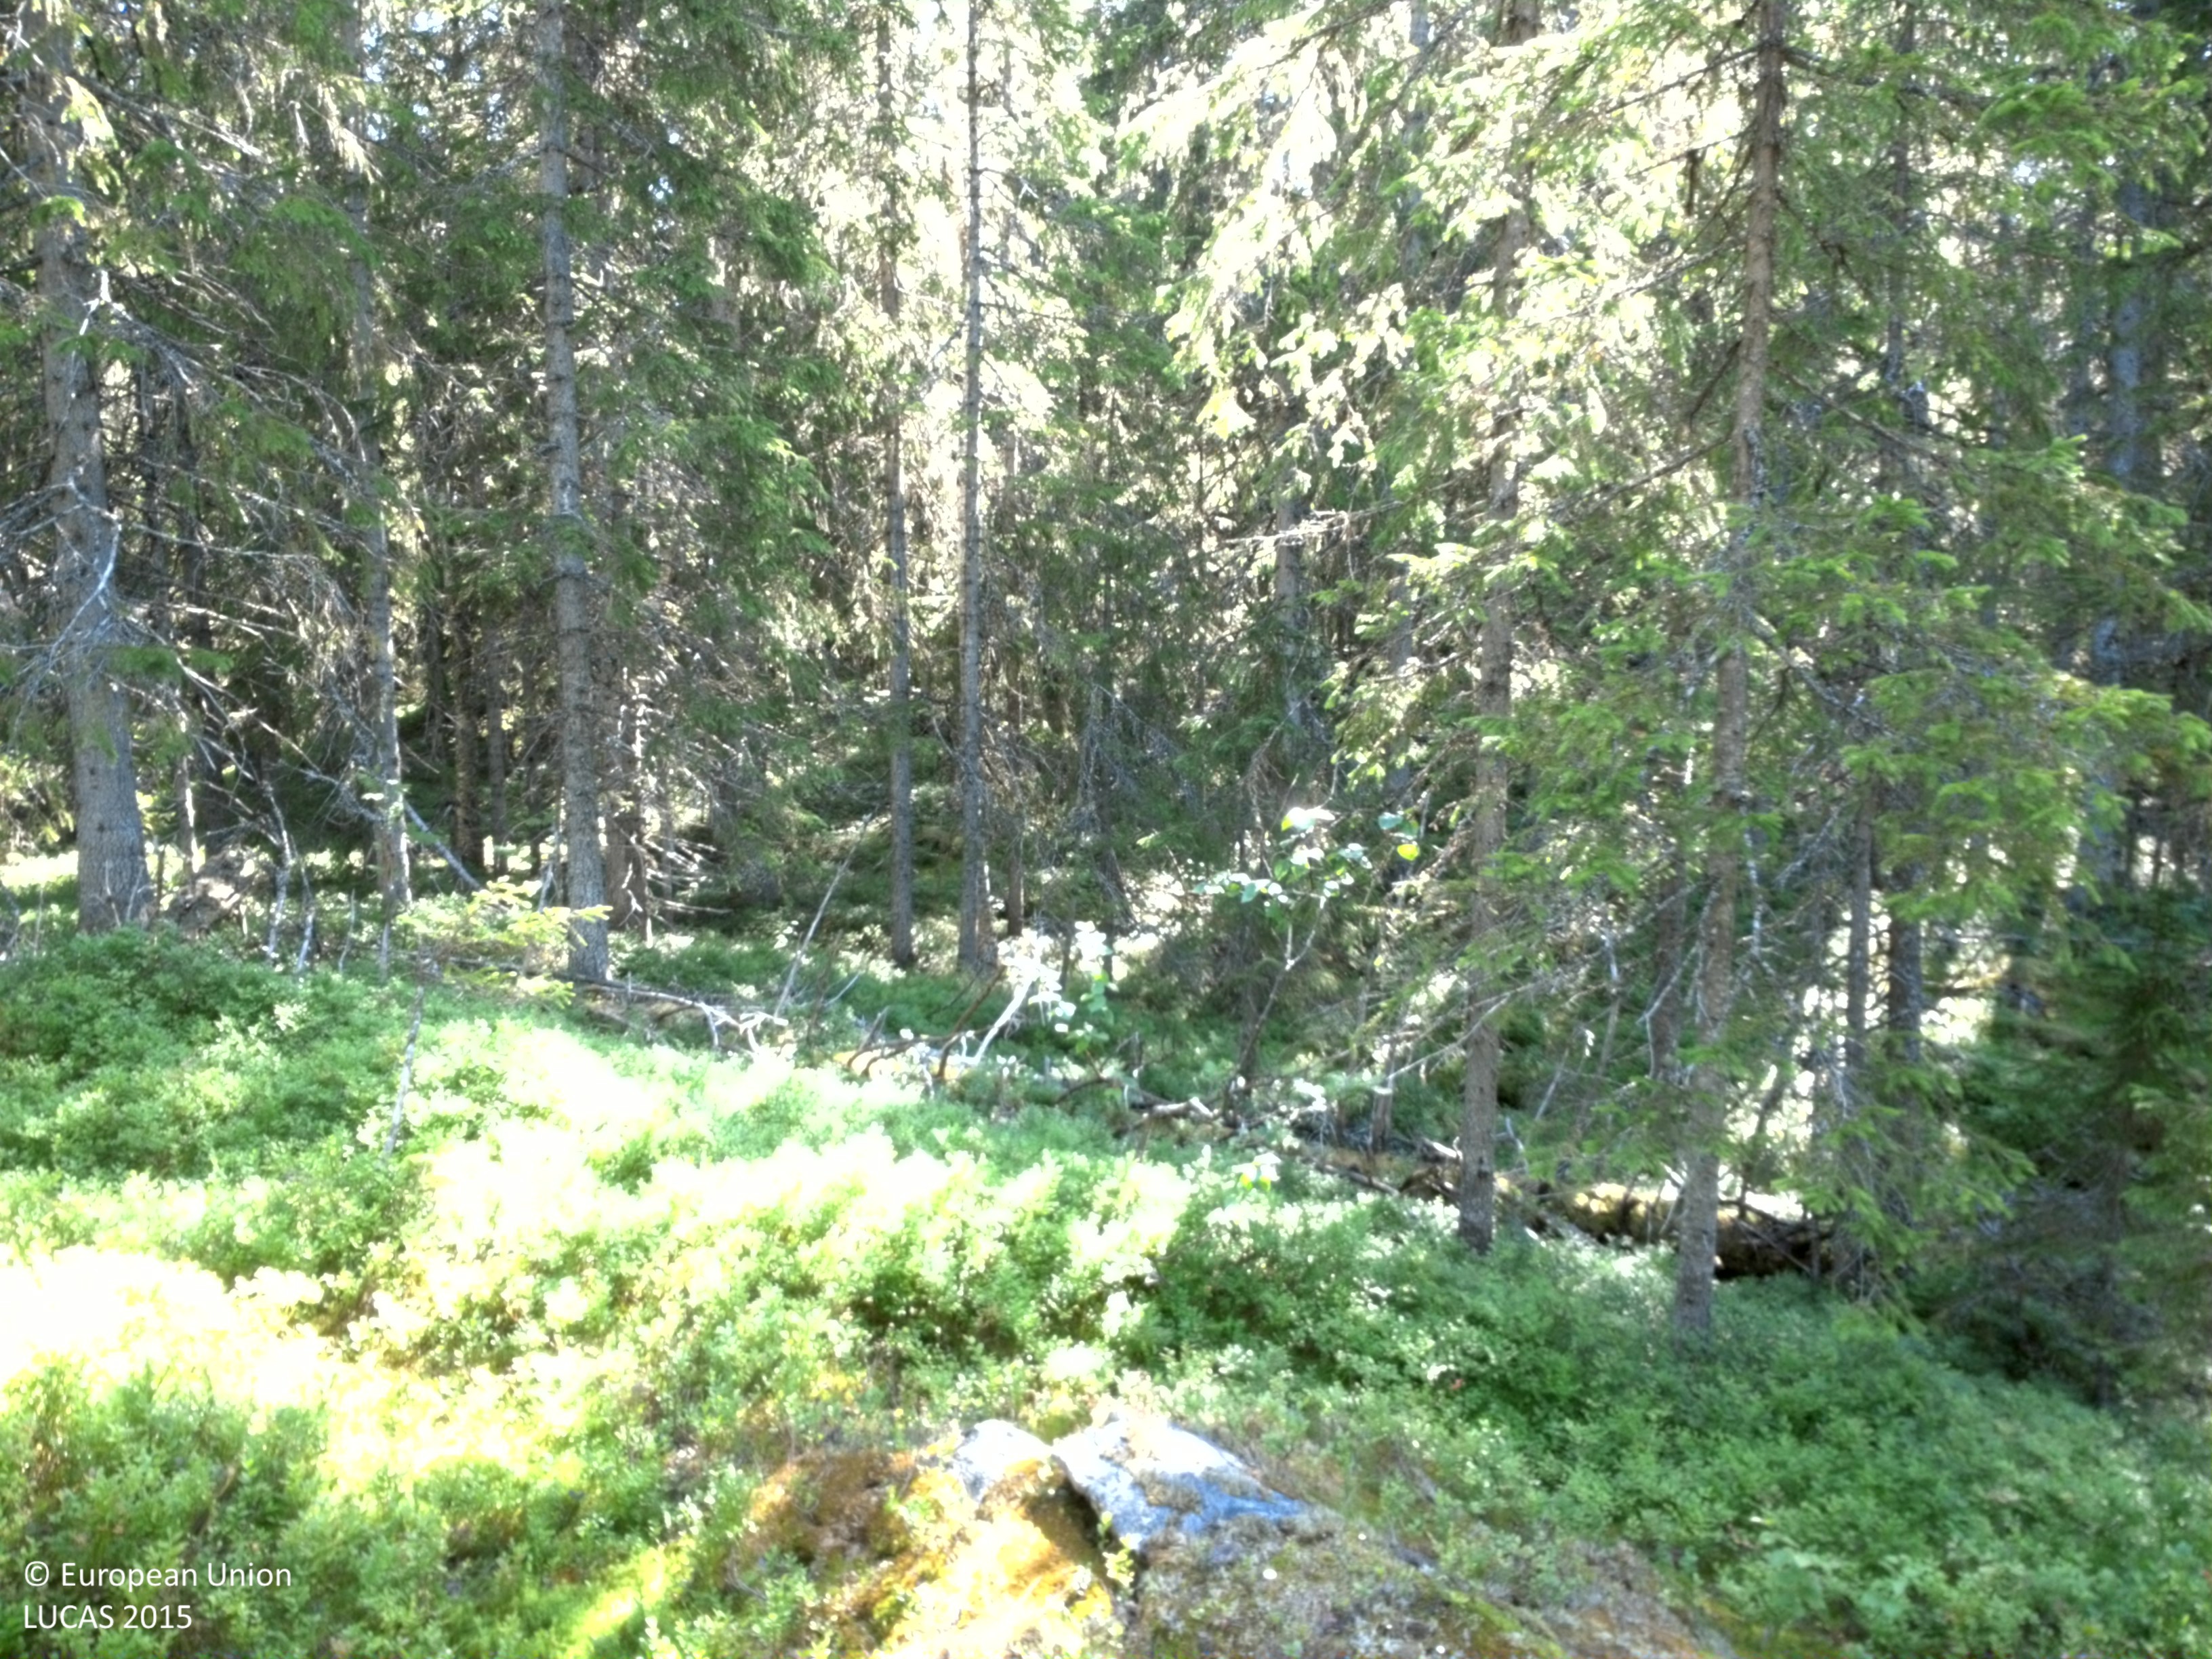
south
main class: Woodland
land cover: Spruce dominated coniferous woodland
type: boreal forest
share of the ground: 25 - 50 %
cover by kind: shrubs 50 %, coniferous forest trees 35 %, lichens and mosses 15 %
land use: Forestry
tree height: > 5 m
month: August
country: SE
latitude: 64.8728
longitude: 15.7715
